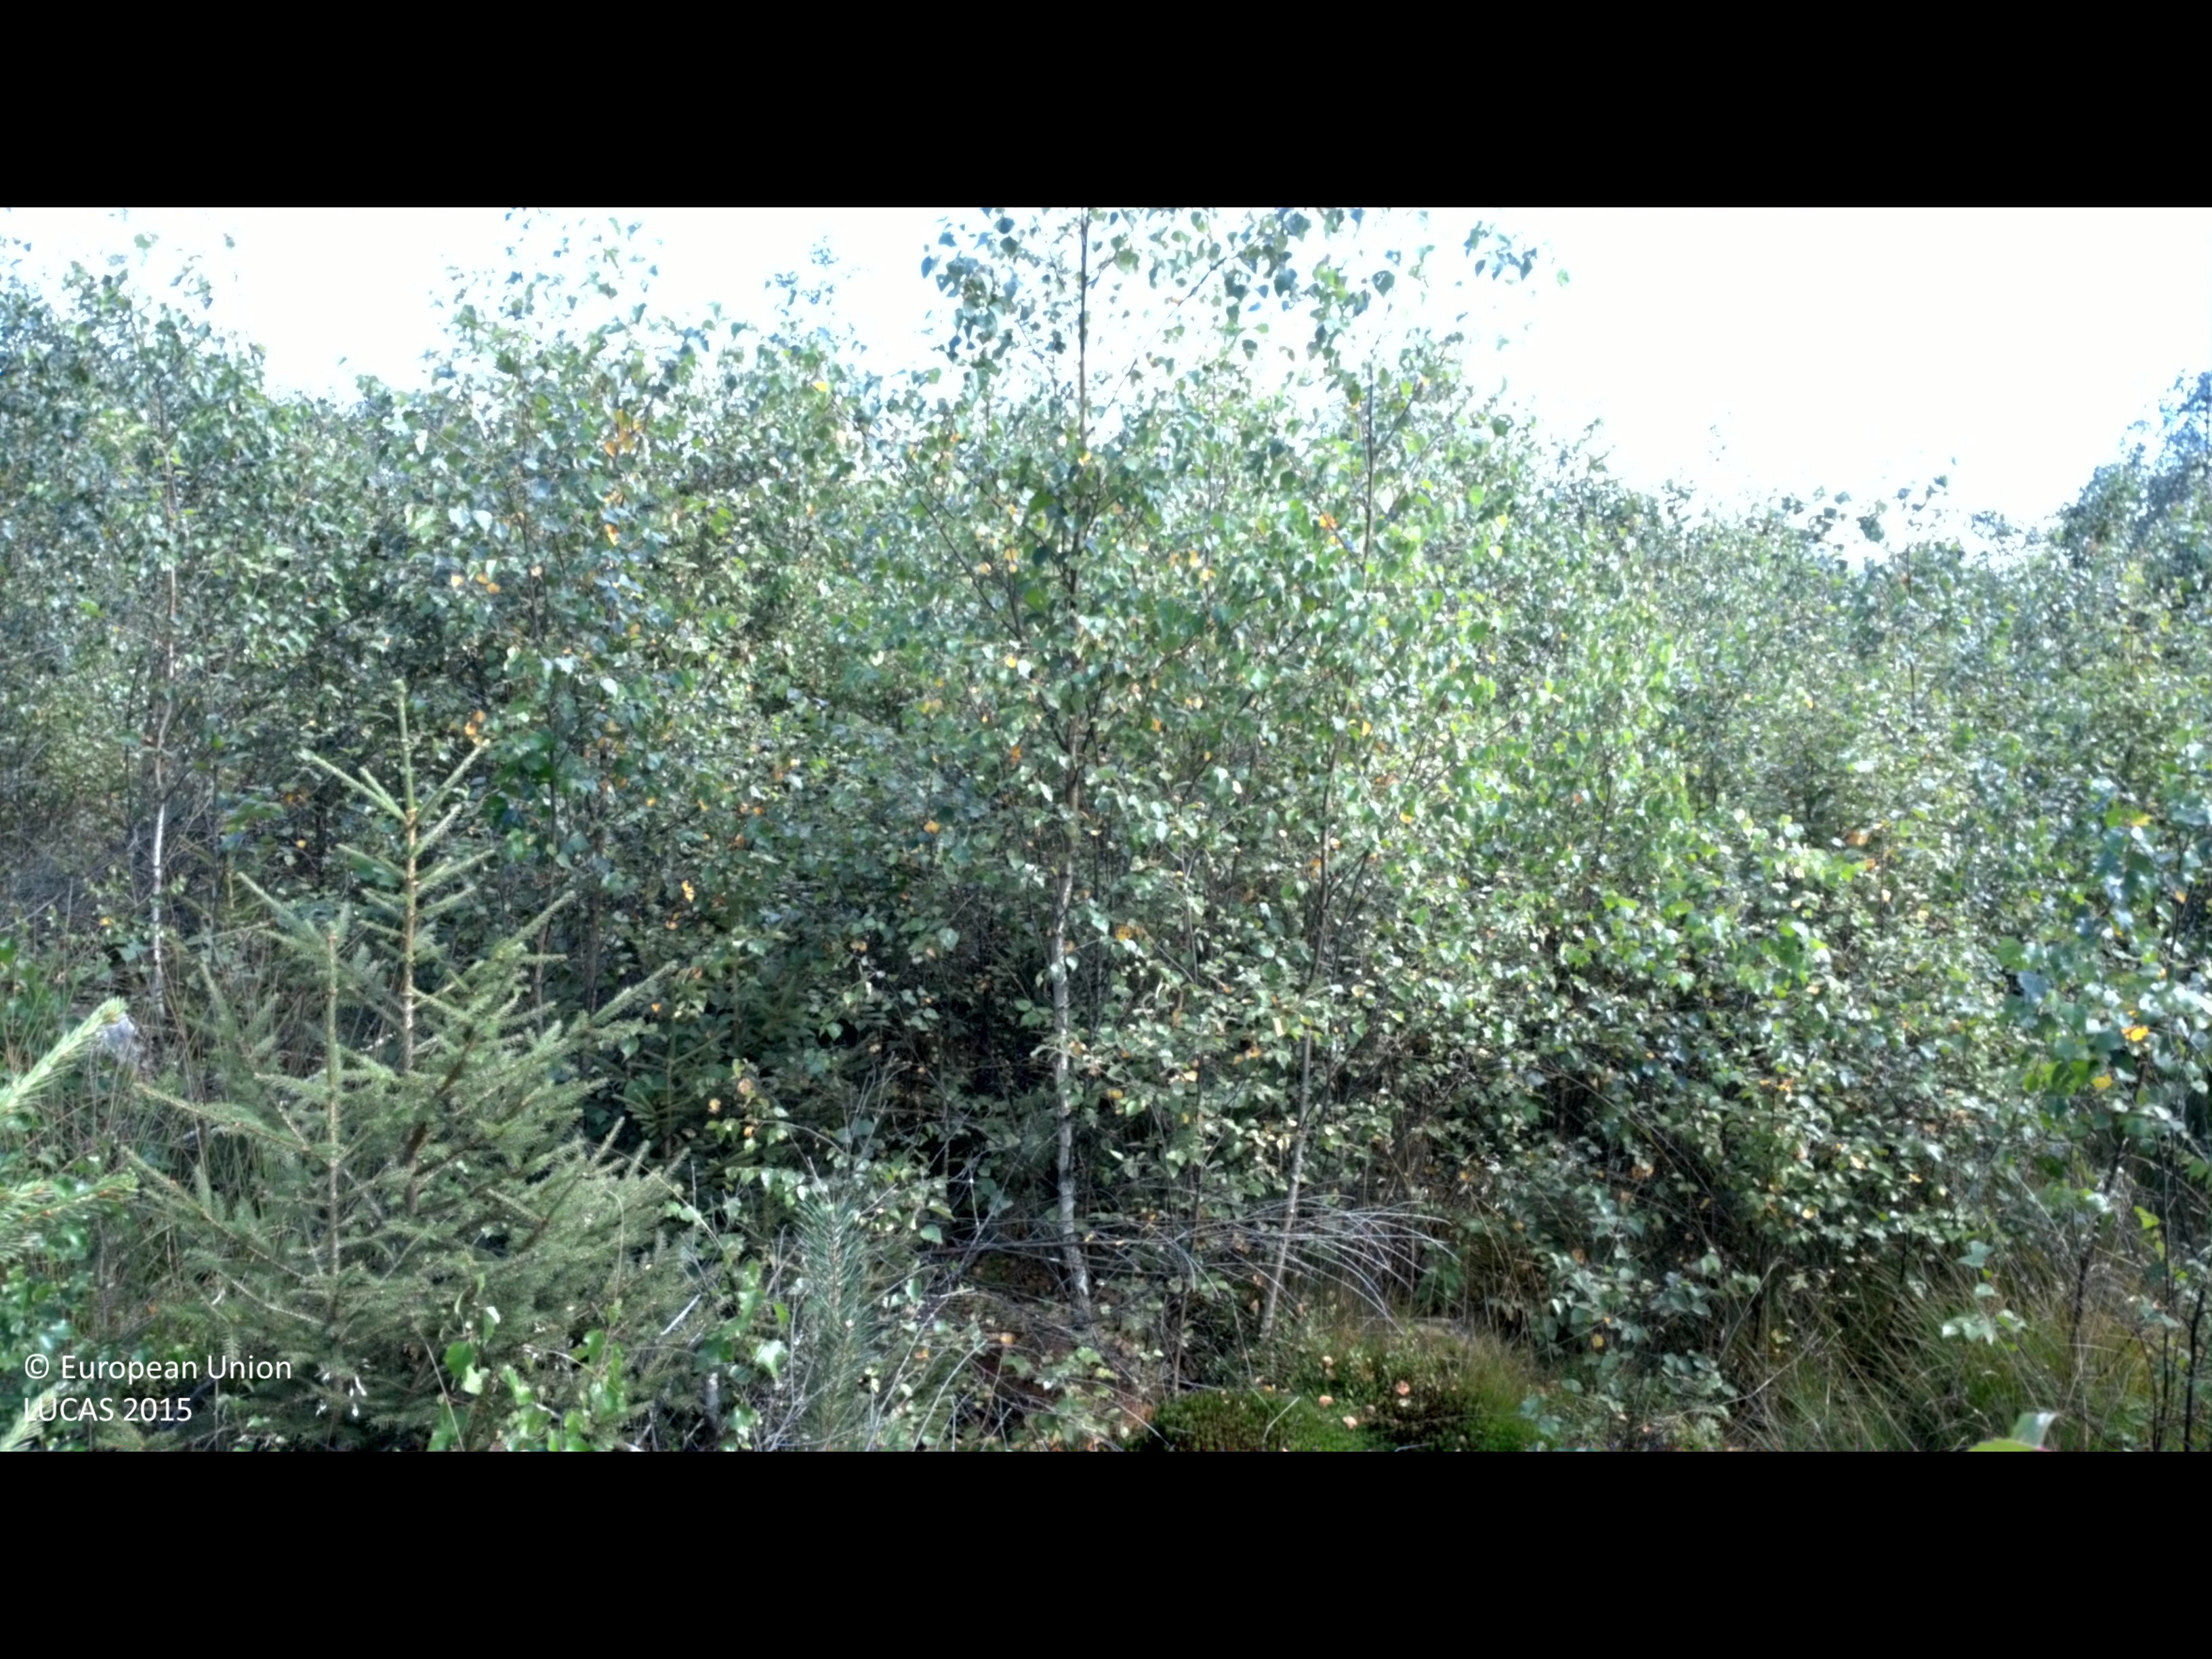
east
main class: Woodland
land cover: Broadleaved woodland
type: boreal forest
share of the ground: 50 - 75 %
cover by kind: broadleaved forest trees 55 %, shrubs 20 %, herbaceous plants 15 %, coniferous forest trees 10 %
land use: Forestry
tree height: < 5 m
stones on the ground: 10 - 25 %
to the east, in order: Broadleaved woodland; Tracks; Broadleaved woodland; Ditches and canals; Broadleaved woodland; Spruce dominated mixed woodland; Tracks
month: August
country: SE
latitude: 56.9776
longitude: 13.7969
